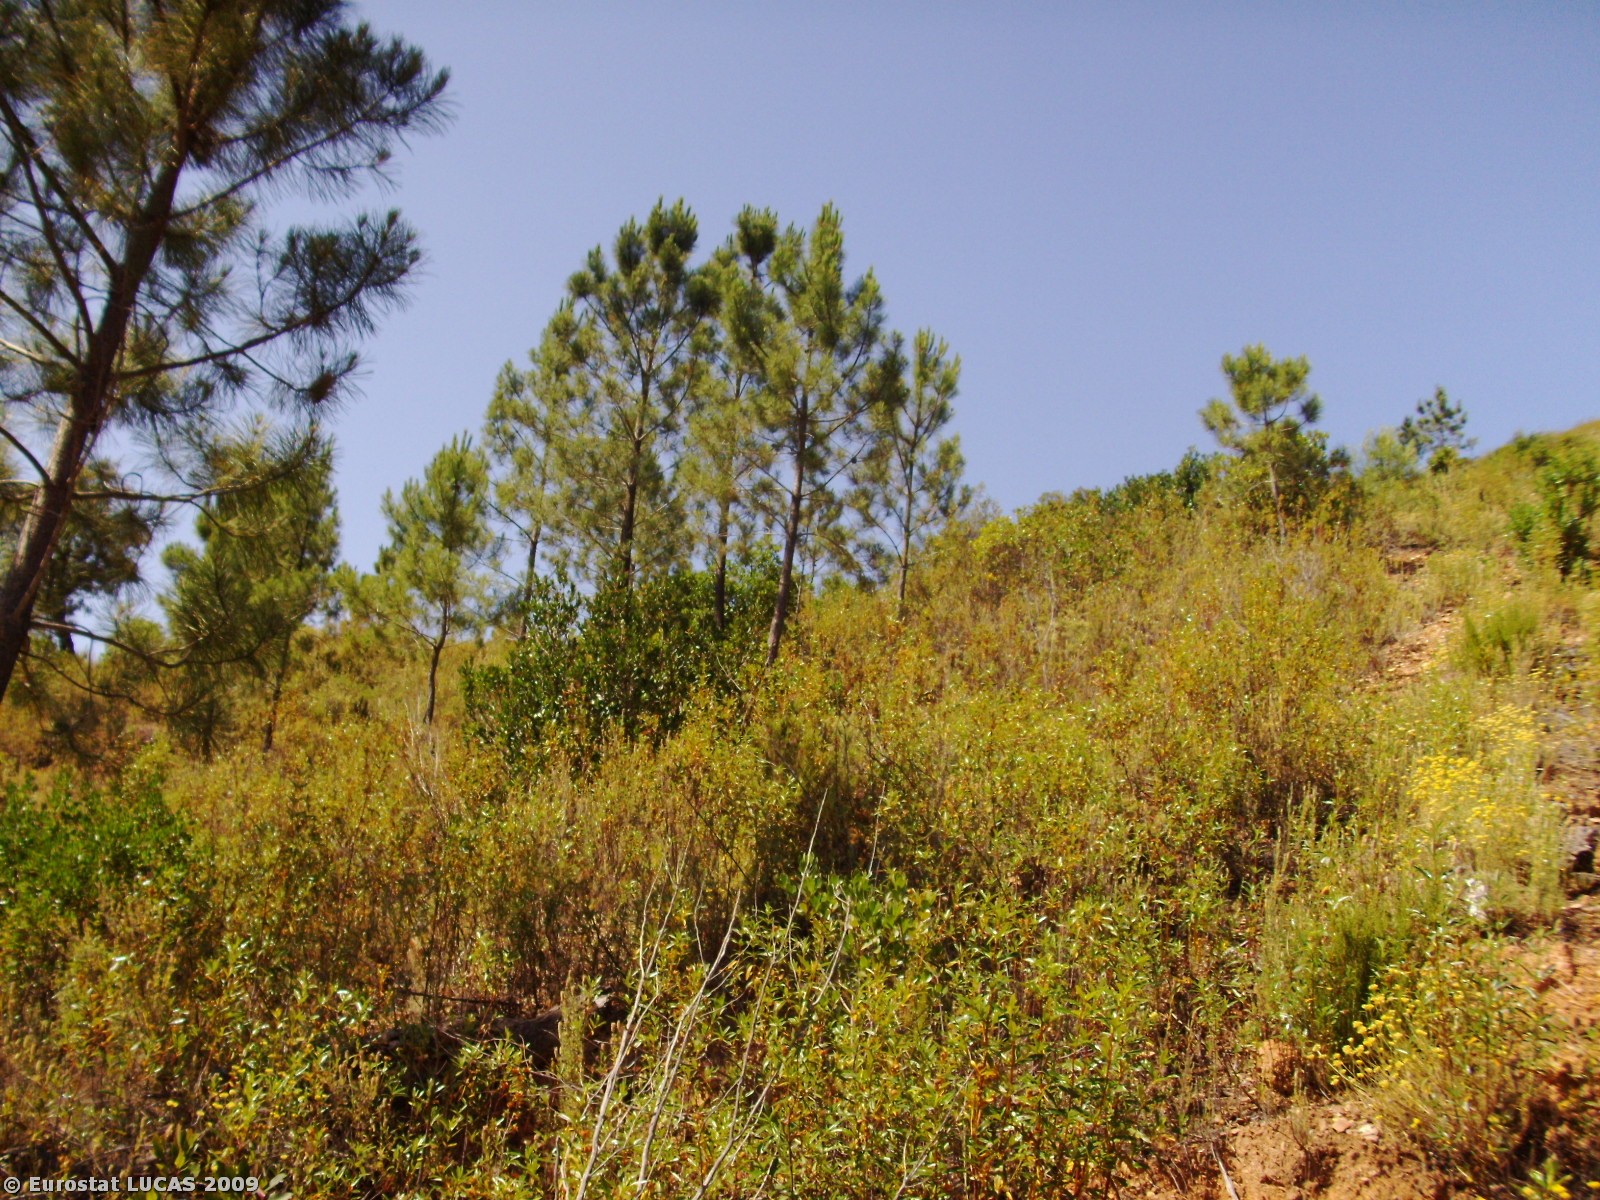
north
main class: Woodland
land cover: Coniferous woodland
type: coniferous forest of the mediterranean region
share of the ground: 25 - 50 %
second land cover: Shrubland with sparse tree cover
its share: 25 - 50 %
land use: Nature reserves
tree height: > 5 m
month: June
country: PT
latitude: 37.3014
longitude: -8.4268
